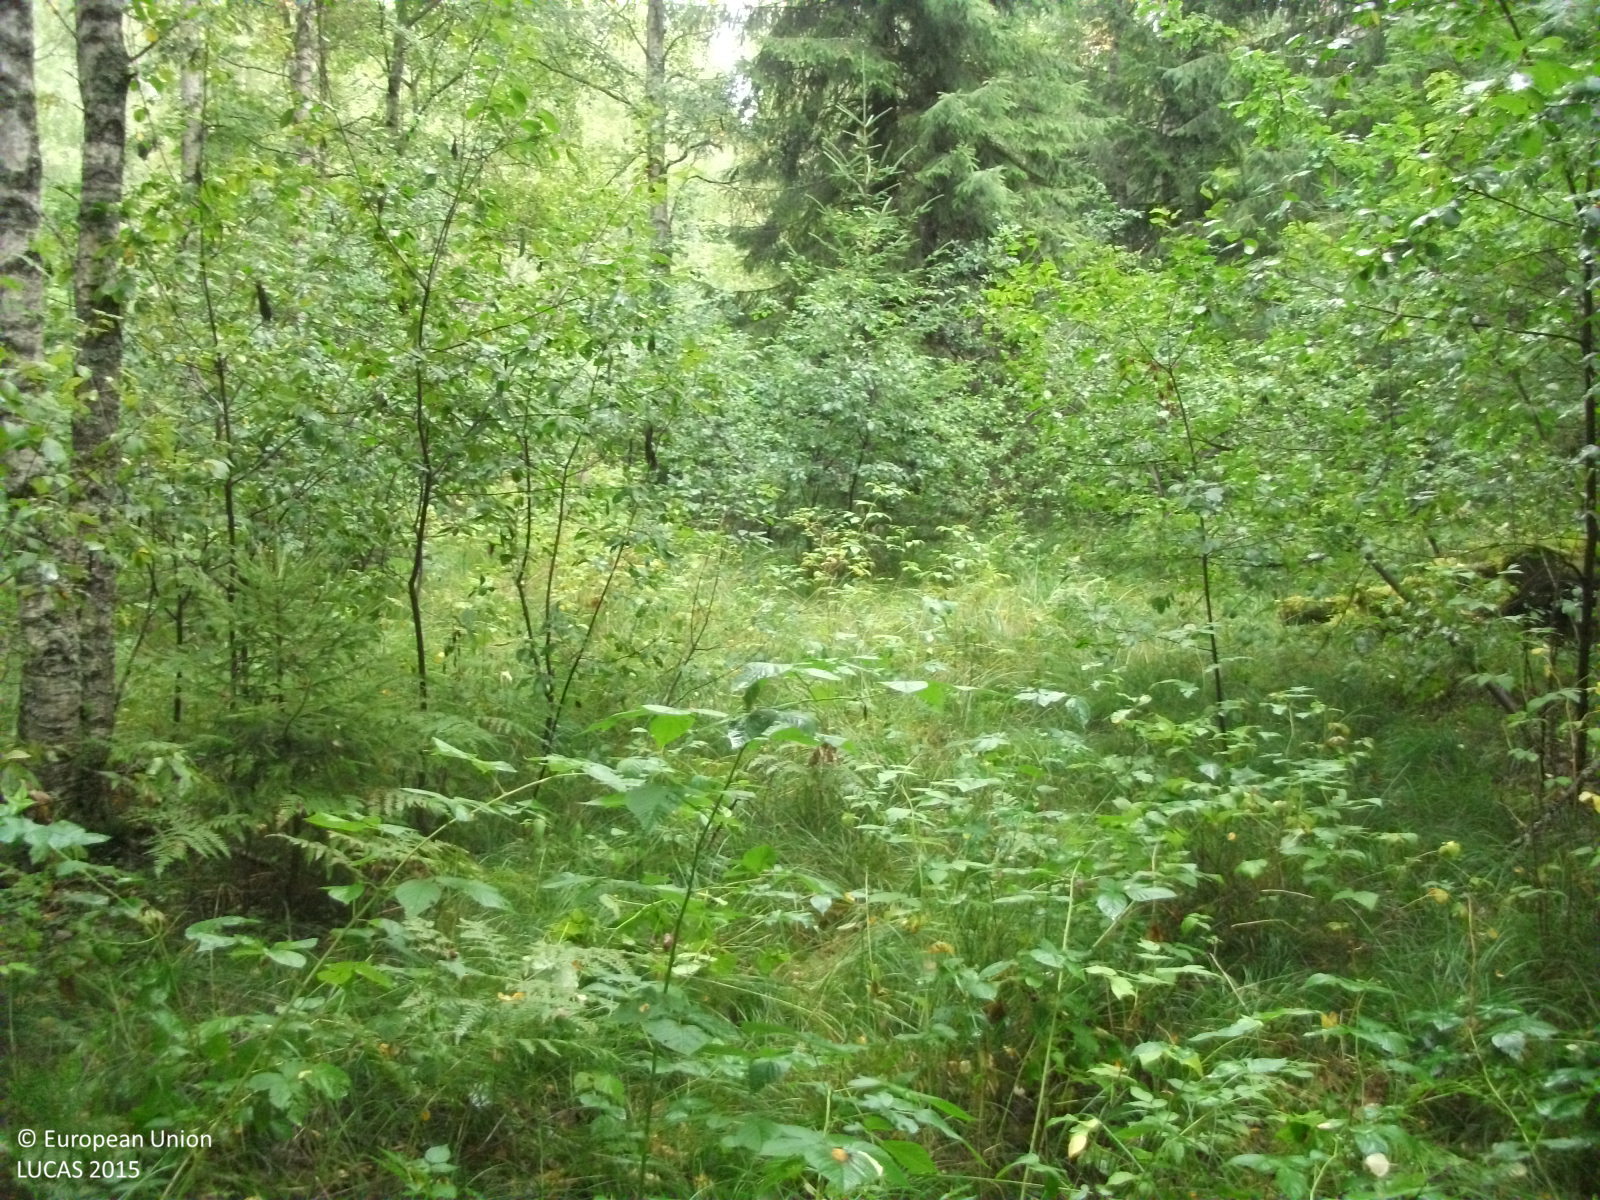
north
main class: Woodland
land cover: Spruce dominated mixed woodland
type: hemiboreal forest and nemoral coniferous forest and mixed broadleaved-coniferous forest
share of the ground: > 75 %
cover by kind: broadleaved forest trees 50 %, coniferous forest trees 25 %, herbaceous plants 15 %, shrubs 10 %
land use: Forestry
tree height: > 5 m
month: September
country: LV
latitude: 57.6085
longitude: 24.8435
